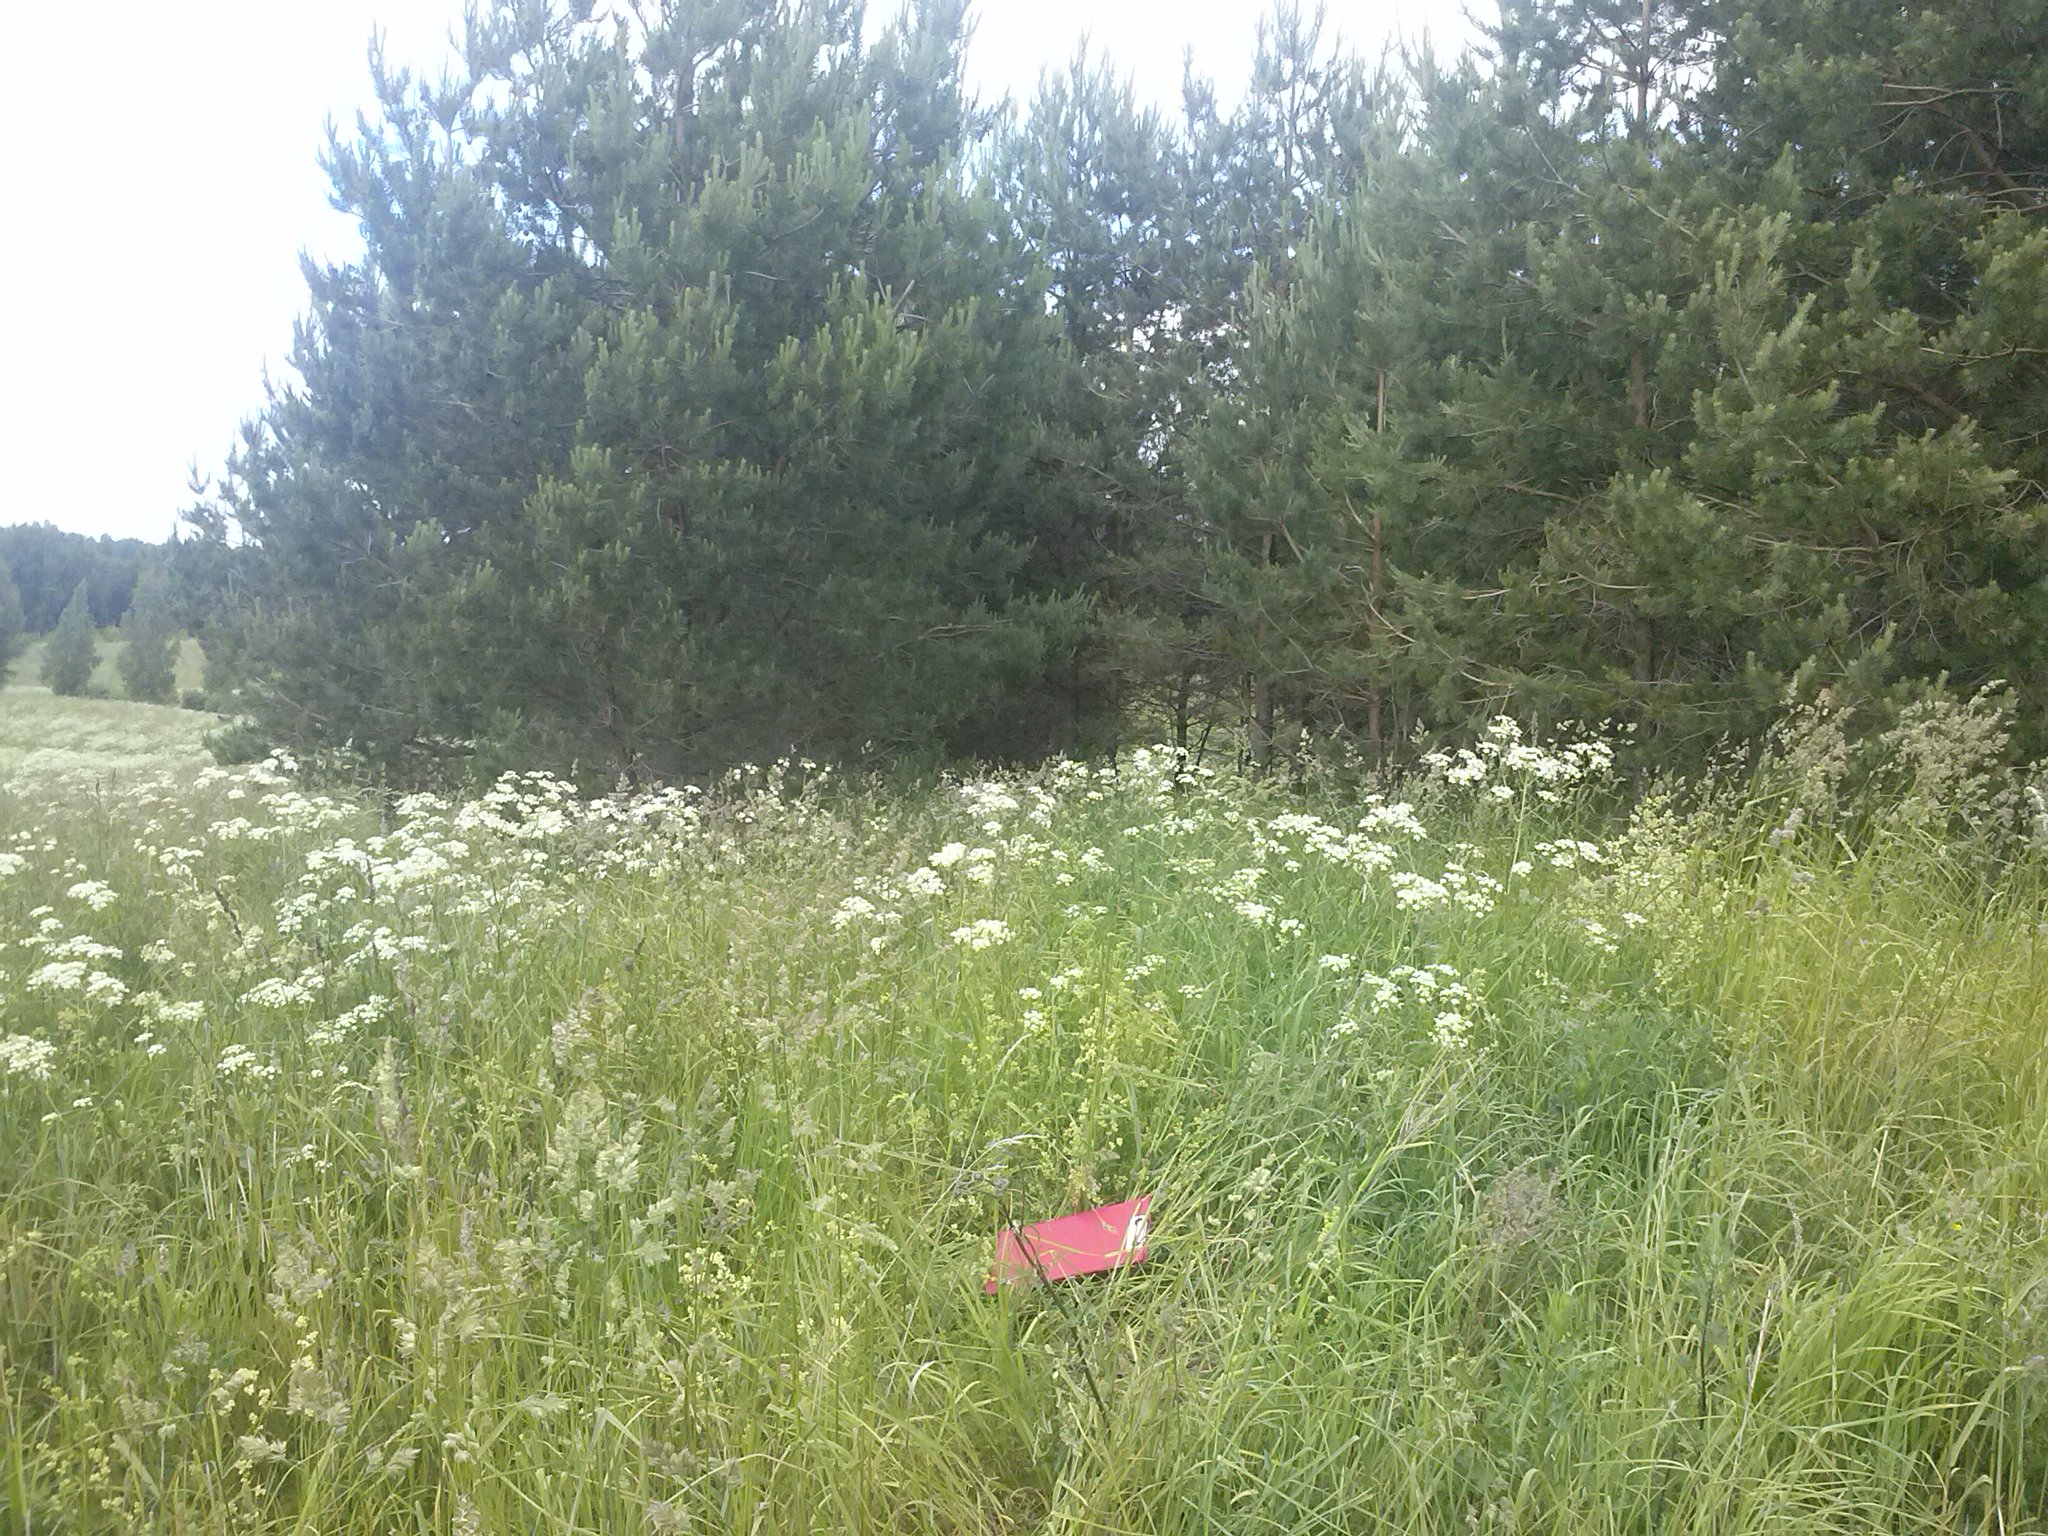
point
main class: Grassland
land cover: Grassland with sparse tree/shrub cover
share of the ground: > 75 %
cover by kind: herbaceous plants 85 %, shrubs 10 %, coniferous forest trees 5 %
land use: Semi-natural and natural areas not in use
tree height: < 5 m
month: June
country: LV
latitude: 56.4696
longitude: 27.8690
